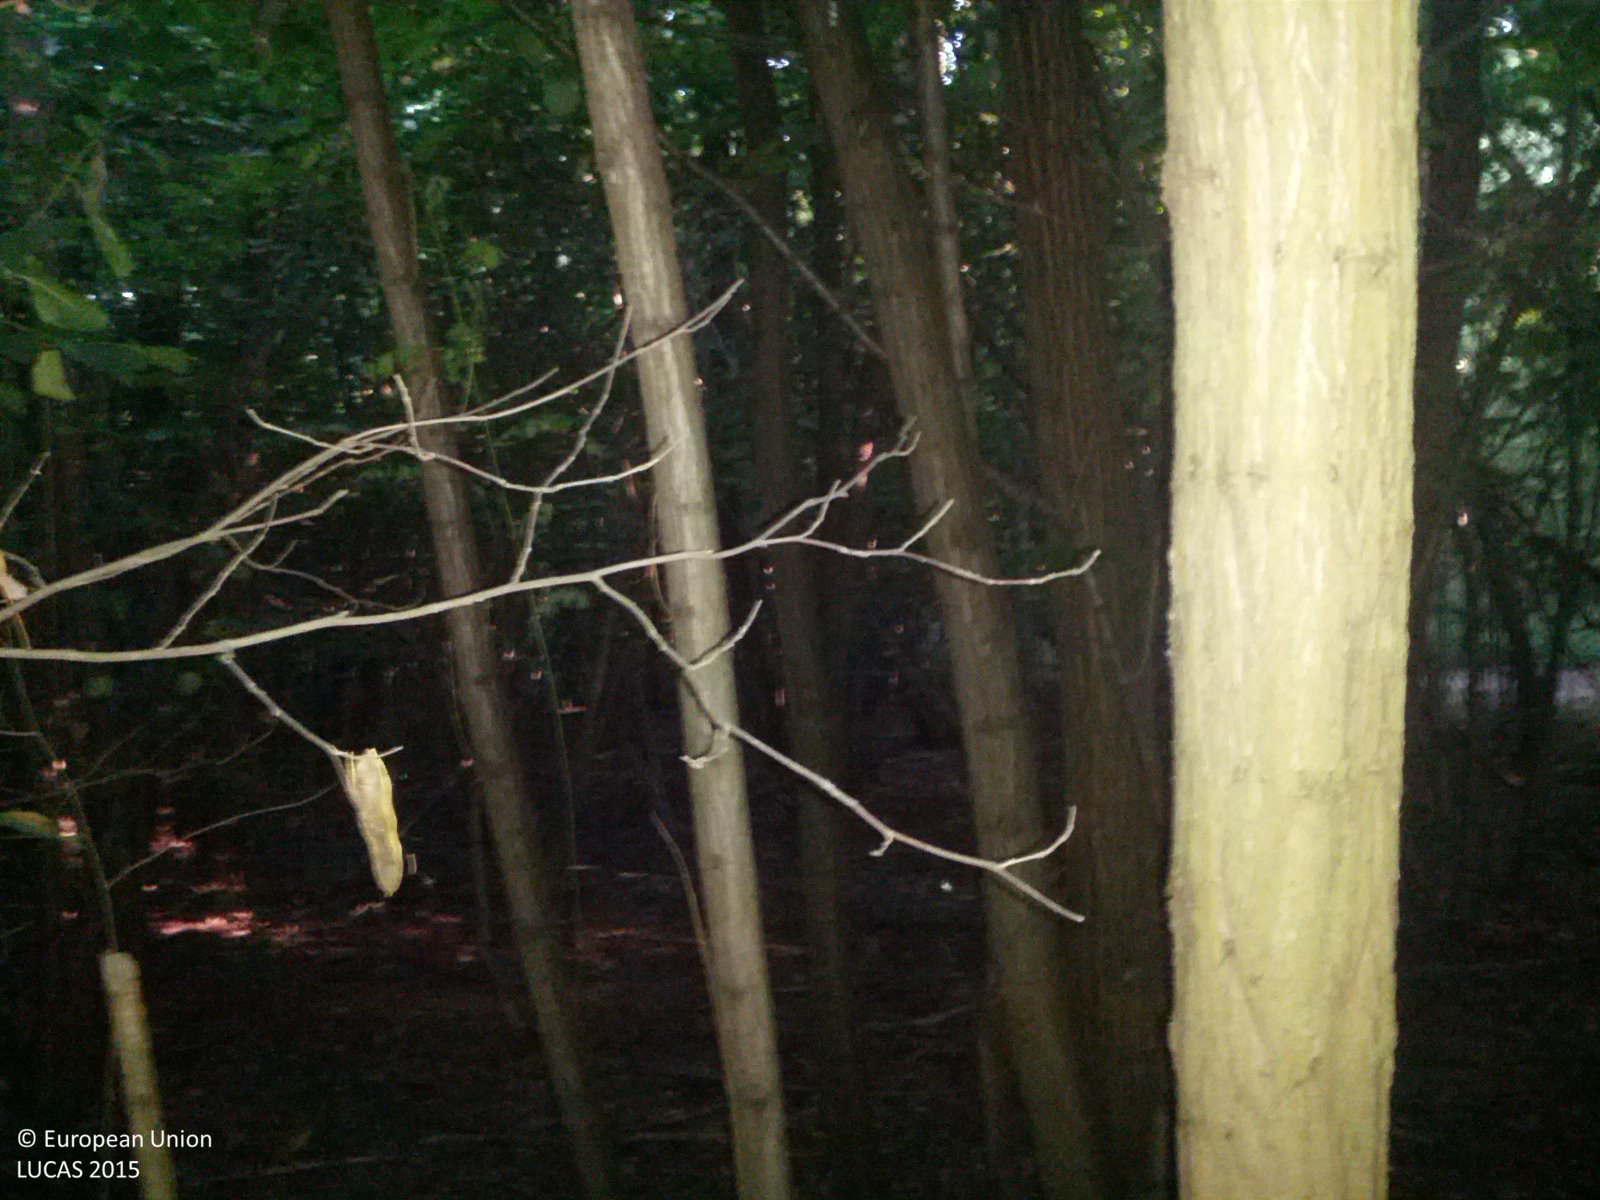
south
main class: Woodland
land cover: Broadleaved woodland
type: mesophytic deciduous forest
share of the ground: > 75 %
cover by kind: broadleaved forest trees 95 %, herbaceous plants 5 %
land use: Forestry
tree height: > 5 m
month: July
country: AT
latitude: 48.6402
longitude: 16.5886
